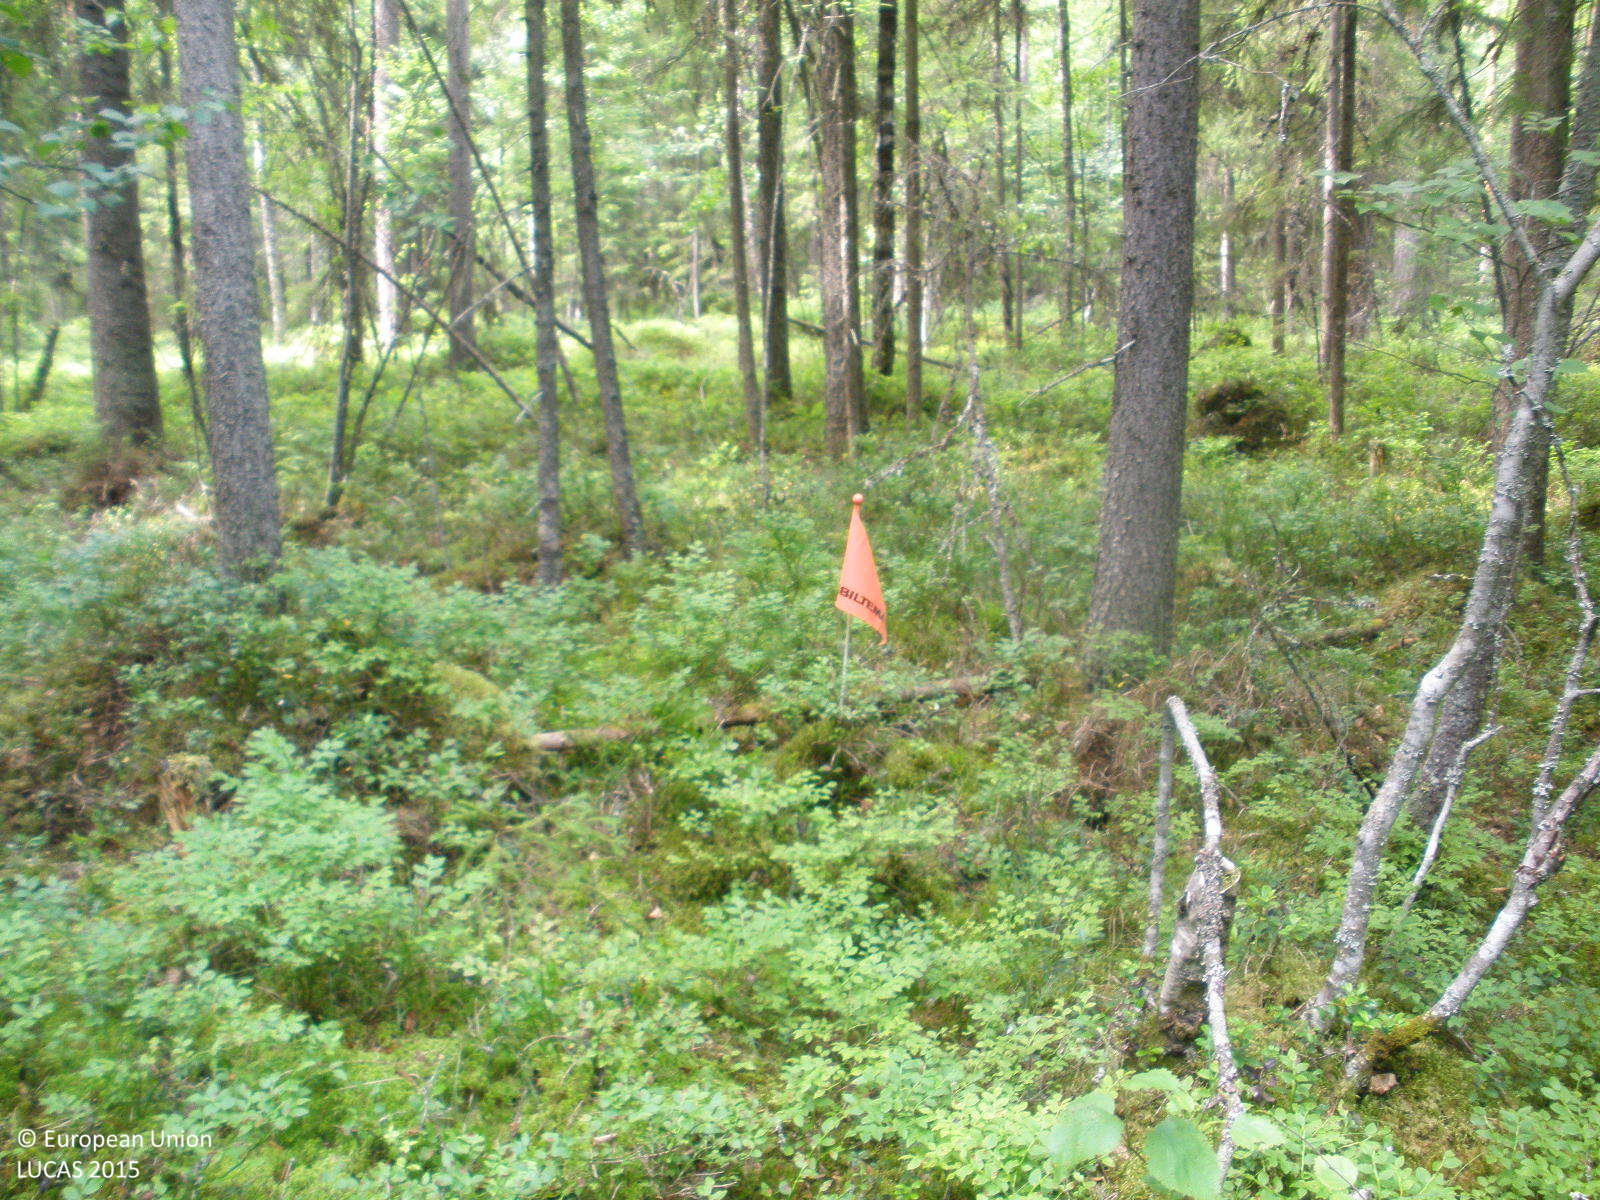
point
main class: Woodland
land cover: Spruce dominated coniferous woodland
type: boreal forest
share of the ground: > 75 %
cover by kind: coniferous forest trees 85 %, broadleaved forest trees 5 %, herbaceous plants 5 %, lichens and mosses 5 %
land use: Forestry
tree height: > 5 m
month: July
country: FI
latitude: 61.4901
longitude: 24.9643
